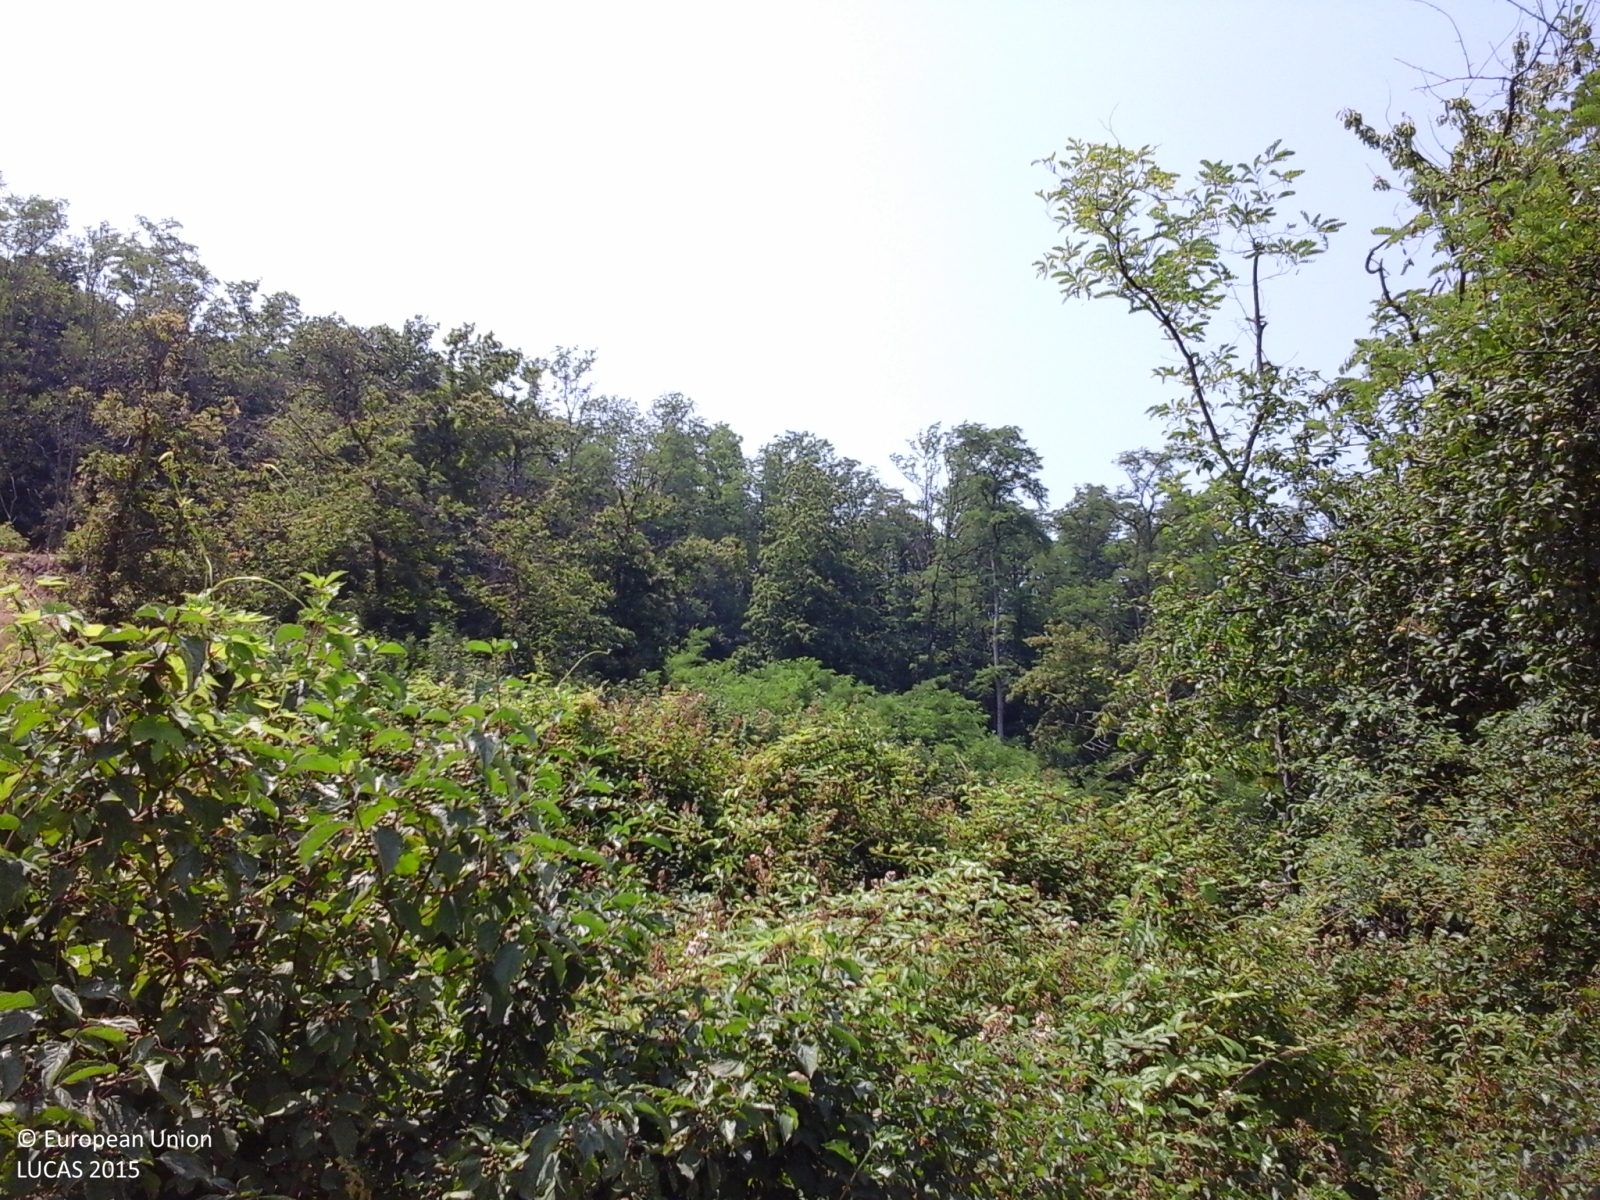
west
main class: Woodland
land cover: Broadleaved woodland
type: thermophilous deciduous forest
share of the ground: > 75 %
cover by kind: broadleaved forest trees 100 %
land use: Forestry
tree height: > 5 m
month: July
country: IT
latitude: 44.7044
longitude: 8.8035
